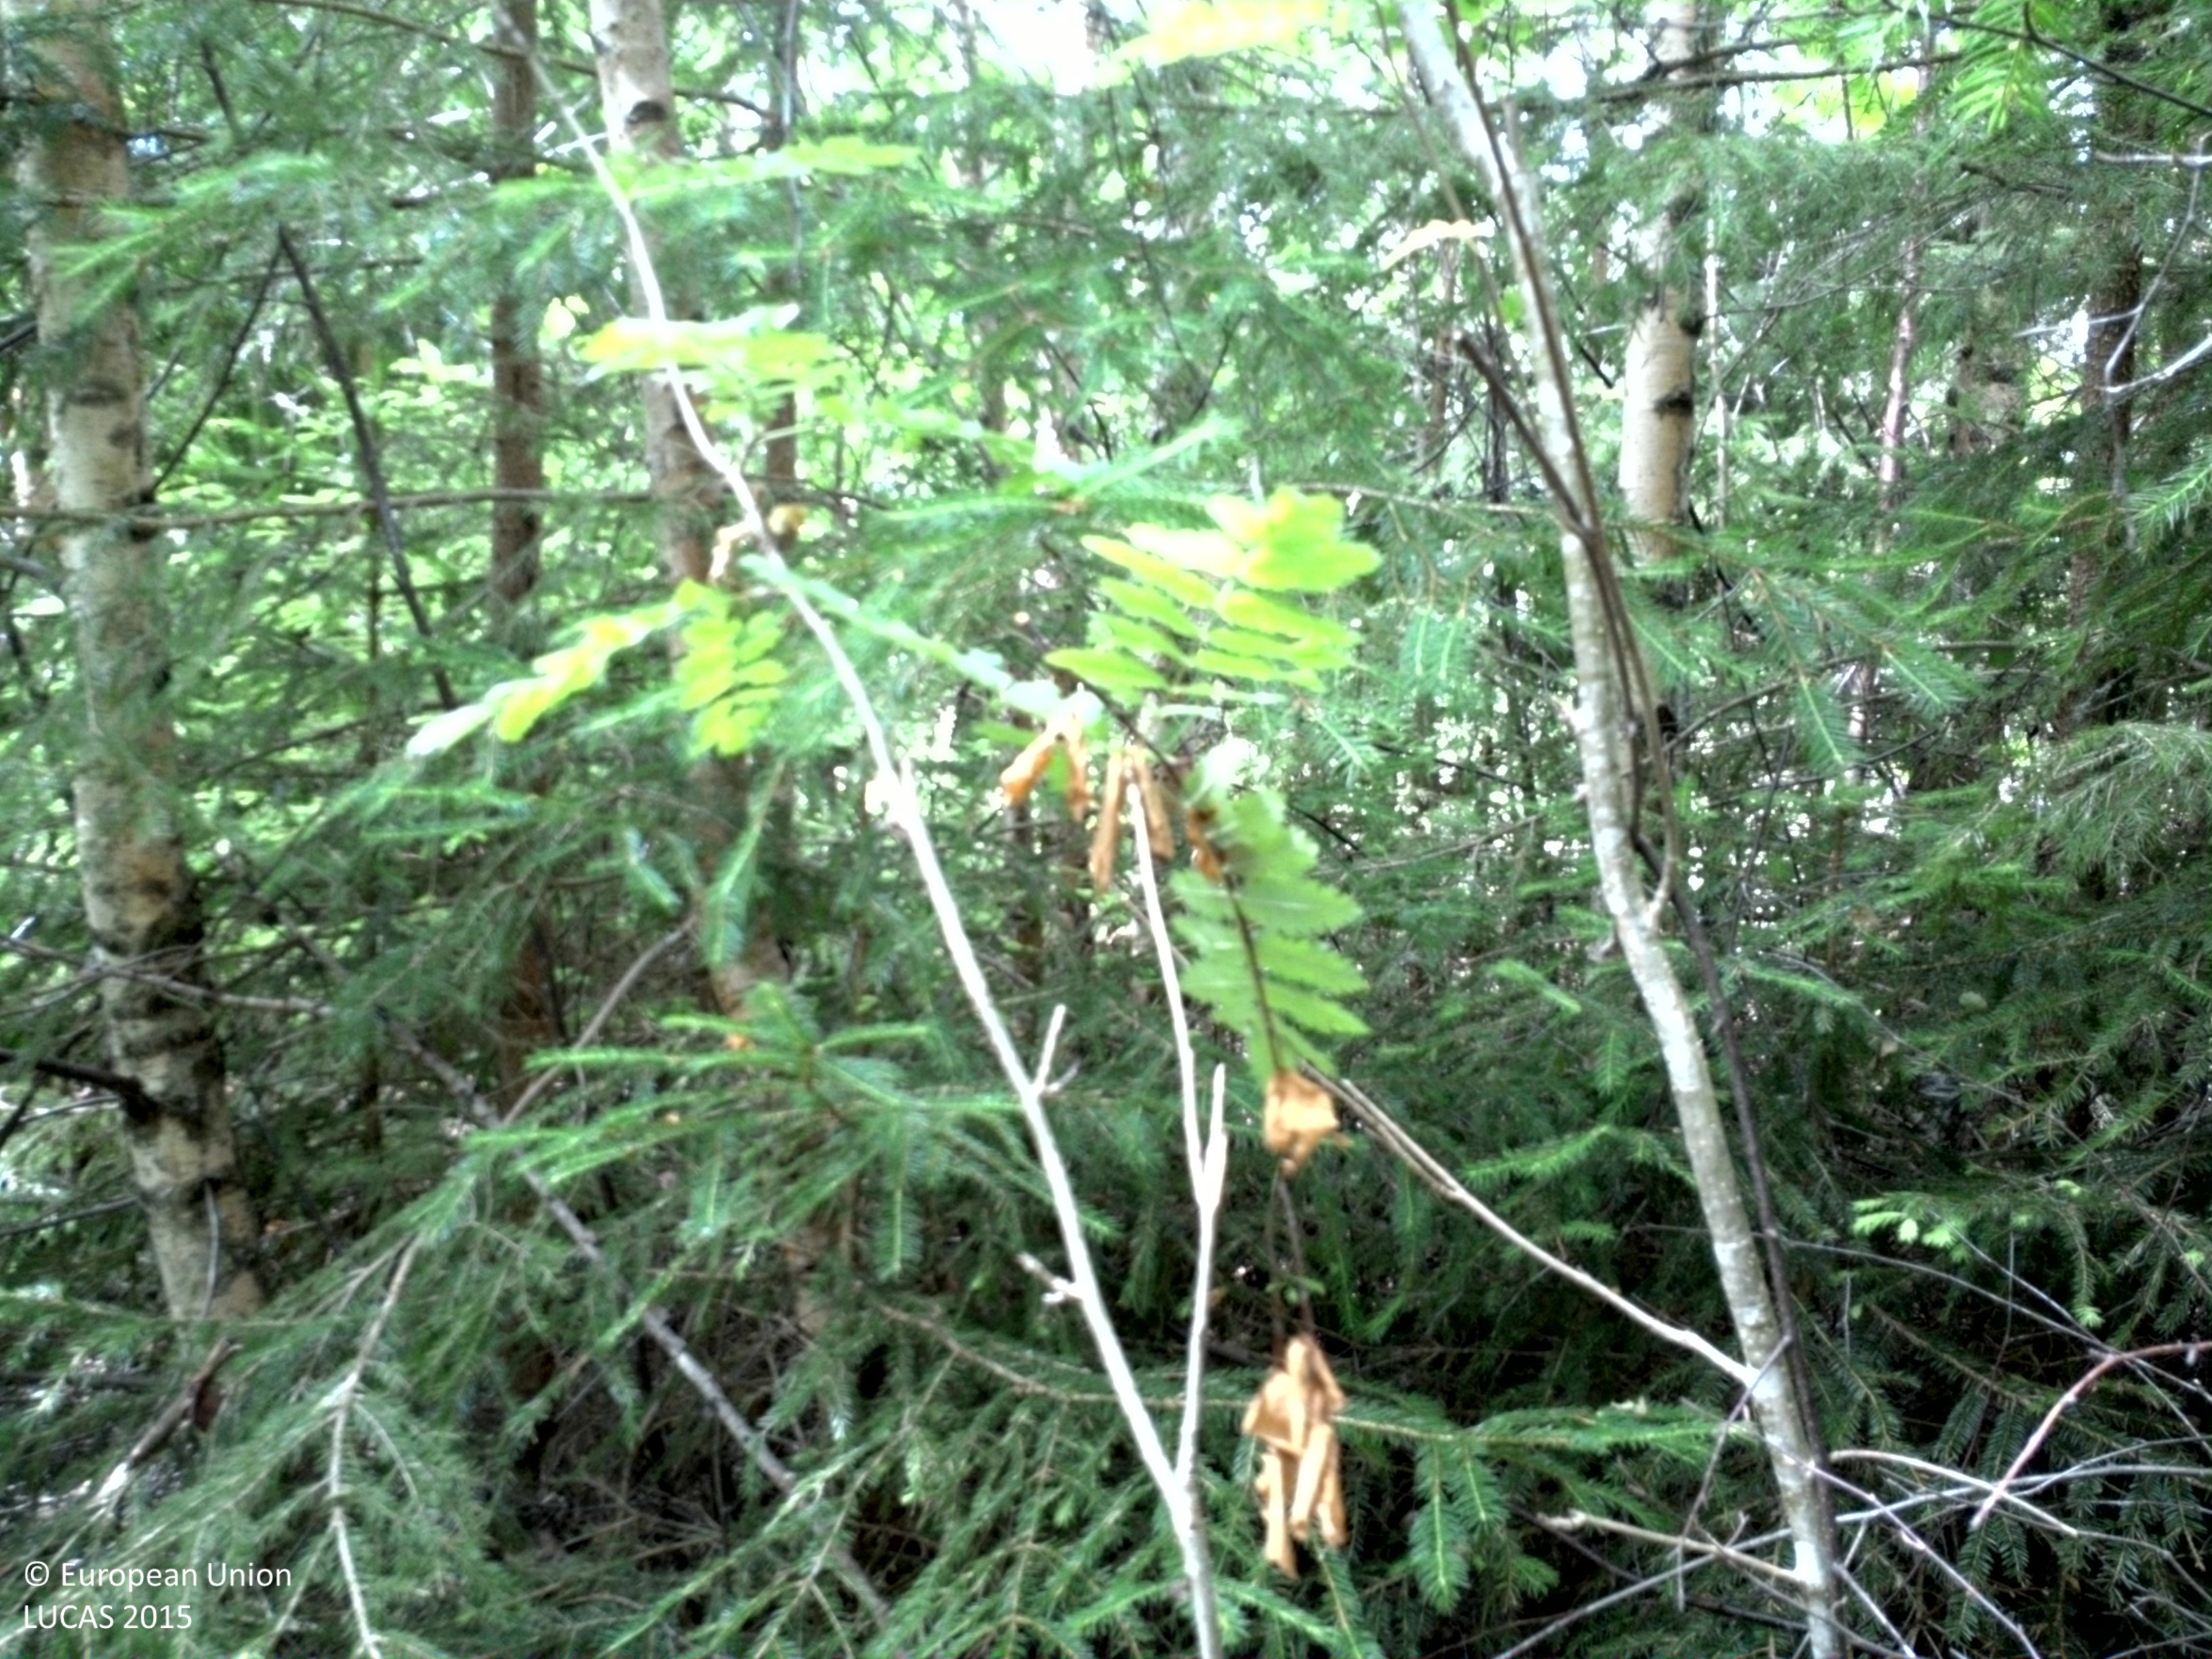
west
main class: Woodland
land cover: Spruce dominated mixed woodland
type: boreal forest
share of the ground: 50 - 75 %
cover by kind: coniferous forest trees 45 %, broadleaved forest trees 25 %, herbaceous plants 25 %, lichens and mosses 5 %
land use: Forestry
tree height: > 5 m
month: July
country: SE
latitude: 58.8274
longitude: 14.5481
